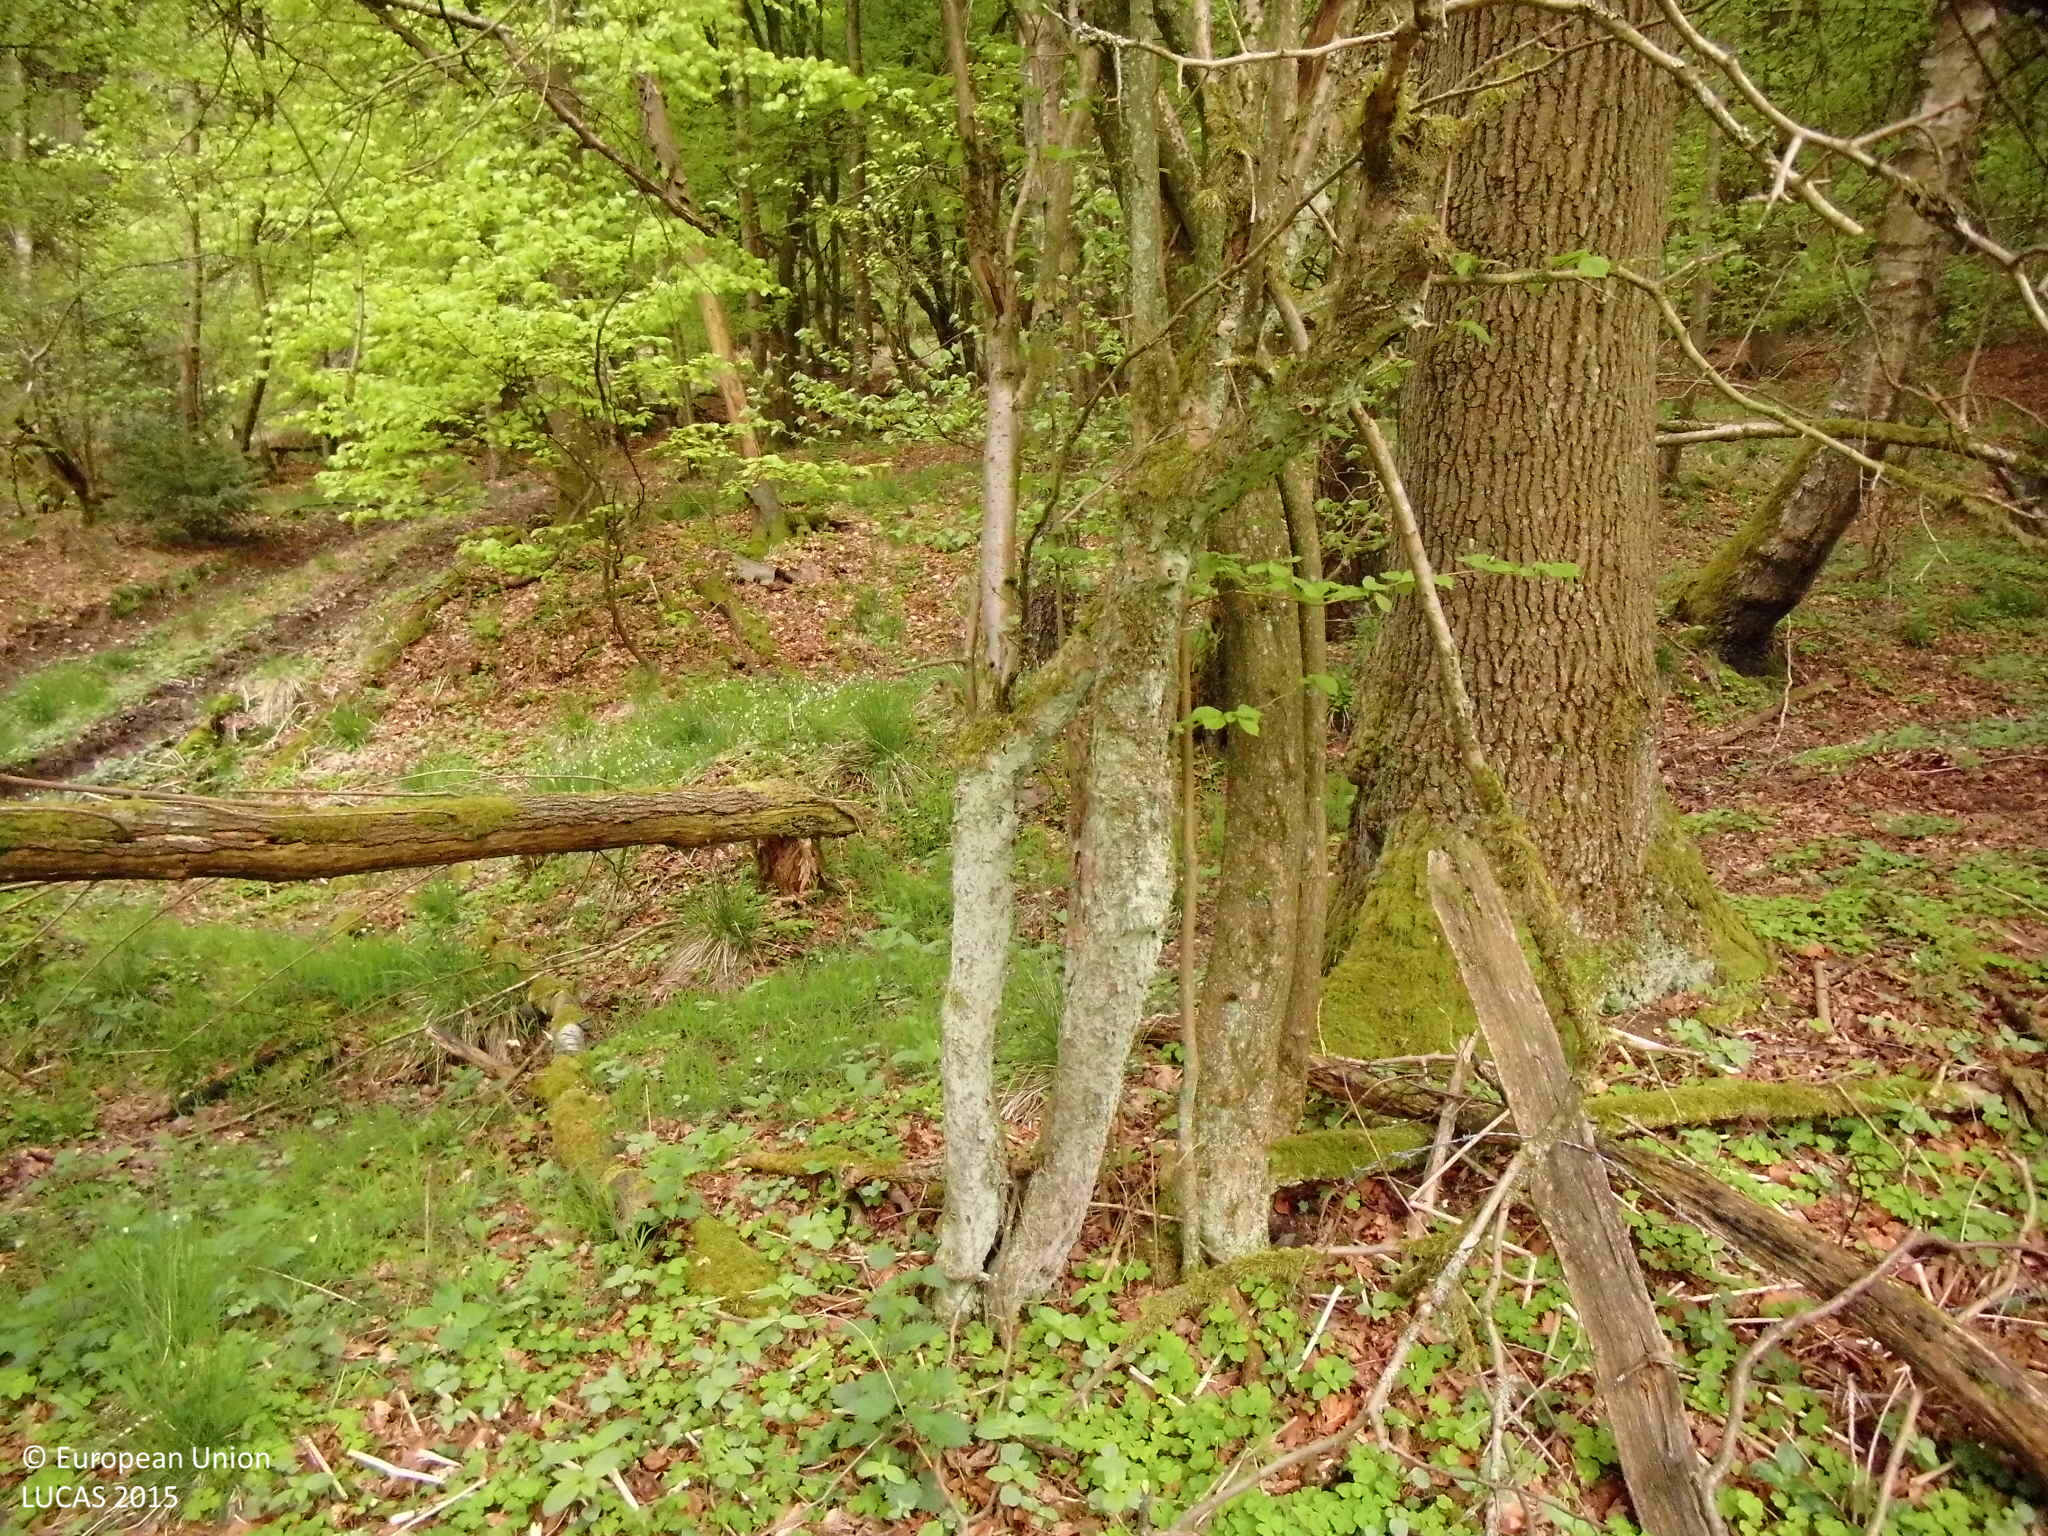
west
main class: Grassland
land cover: Grassland without tree/shrub cover
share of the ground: > 75 %
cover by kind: herbaceous plants 75 %, unconsolidated bare surface 20 %, shrubs 5 %
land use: Agriculture (excluding fallow land and kitchen gardens)
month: May
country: DE
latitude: 51.2540
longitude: 7.4928
